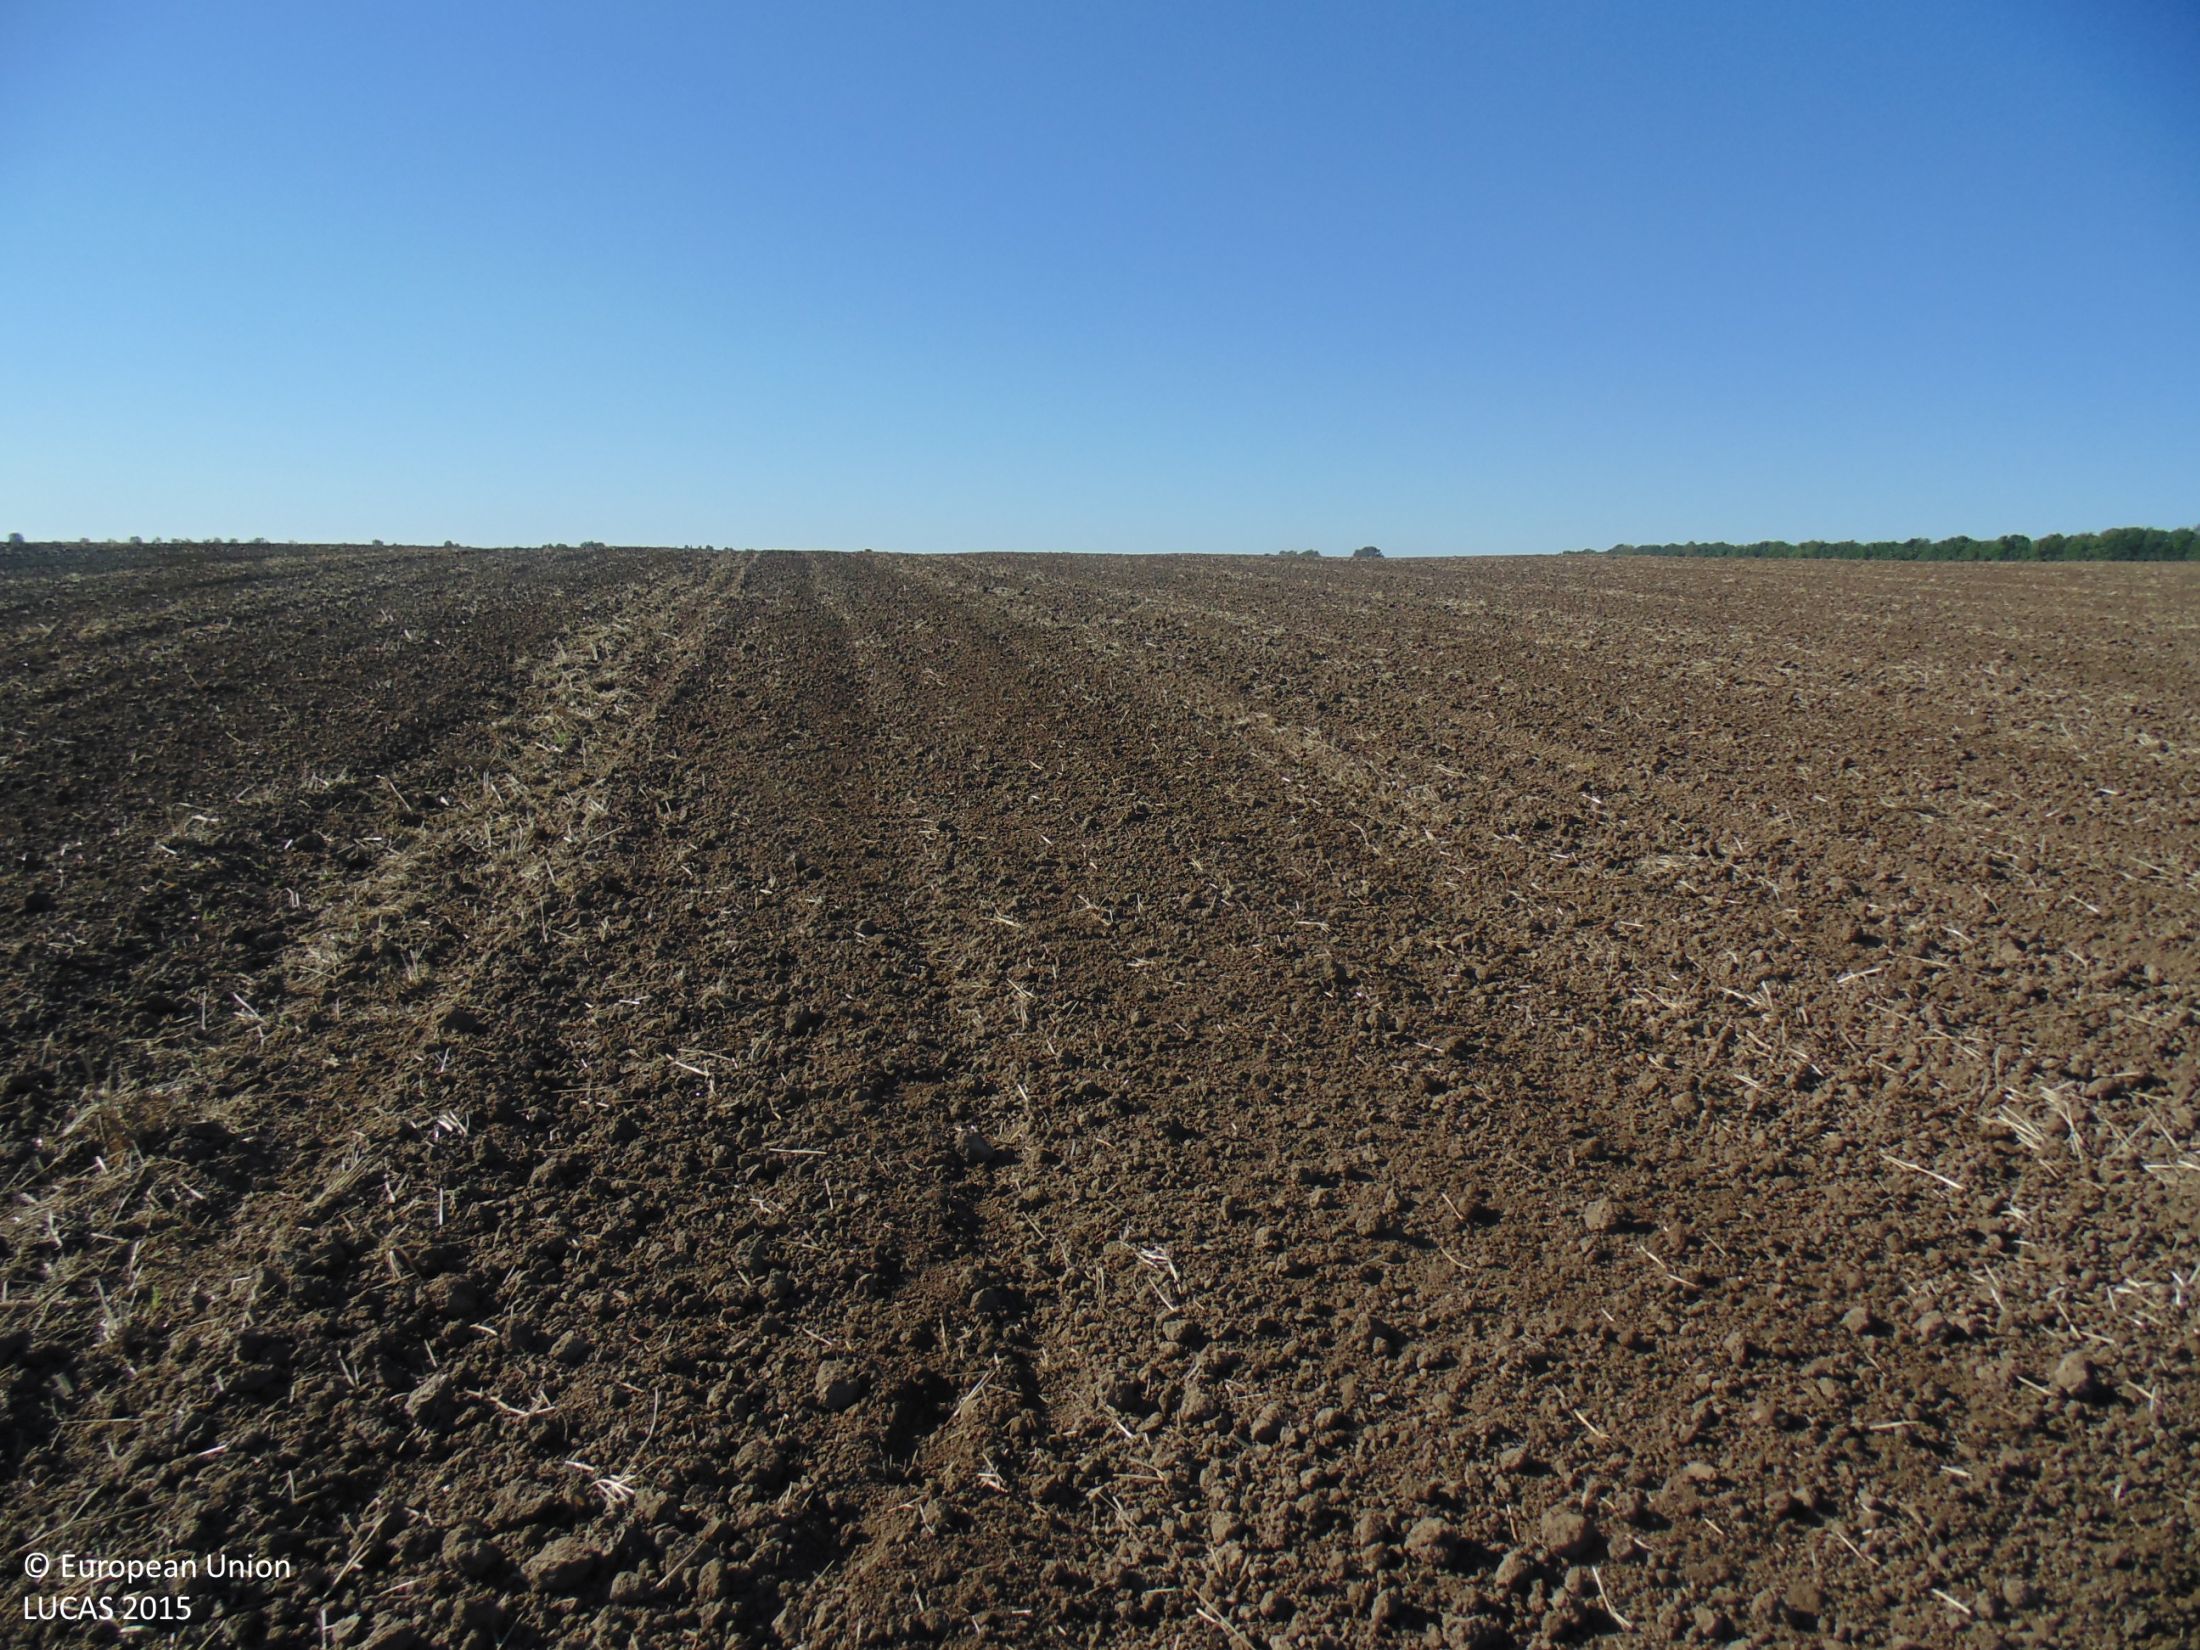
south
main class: Cropland
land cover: Common wheat
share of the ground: < 10 %
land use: Agriculture (excluding fallow land and kitchen gardens)
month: September
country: BG
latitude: 43.7663
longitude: 27.3089
